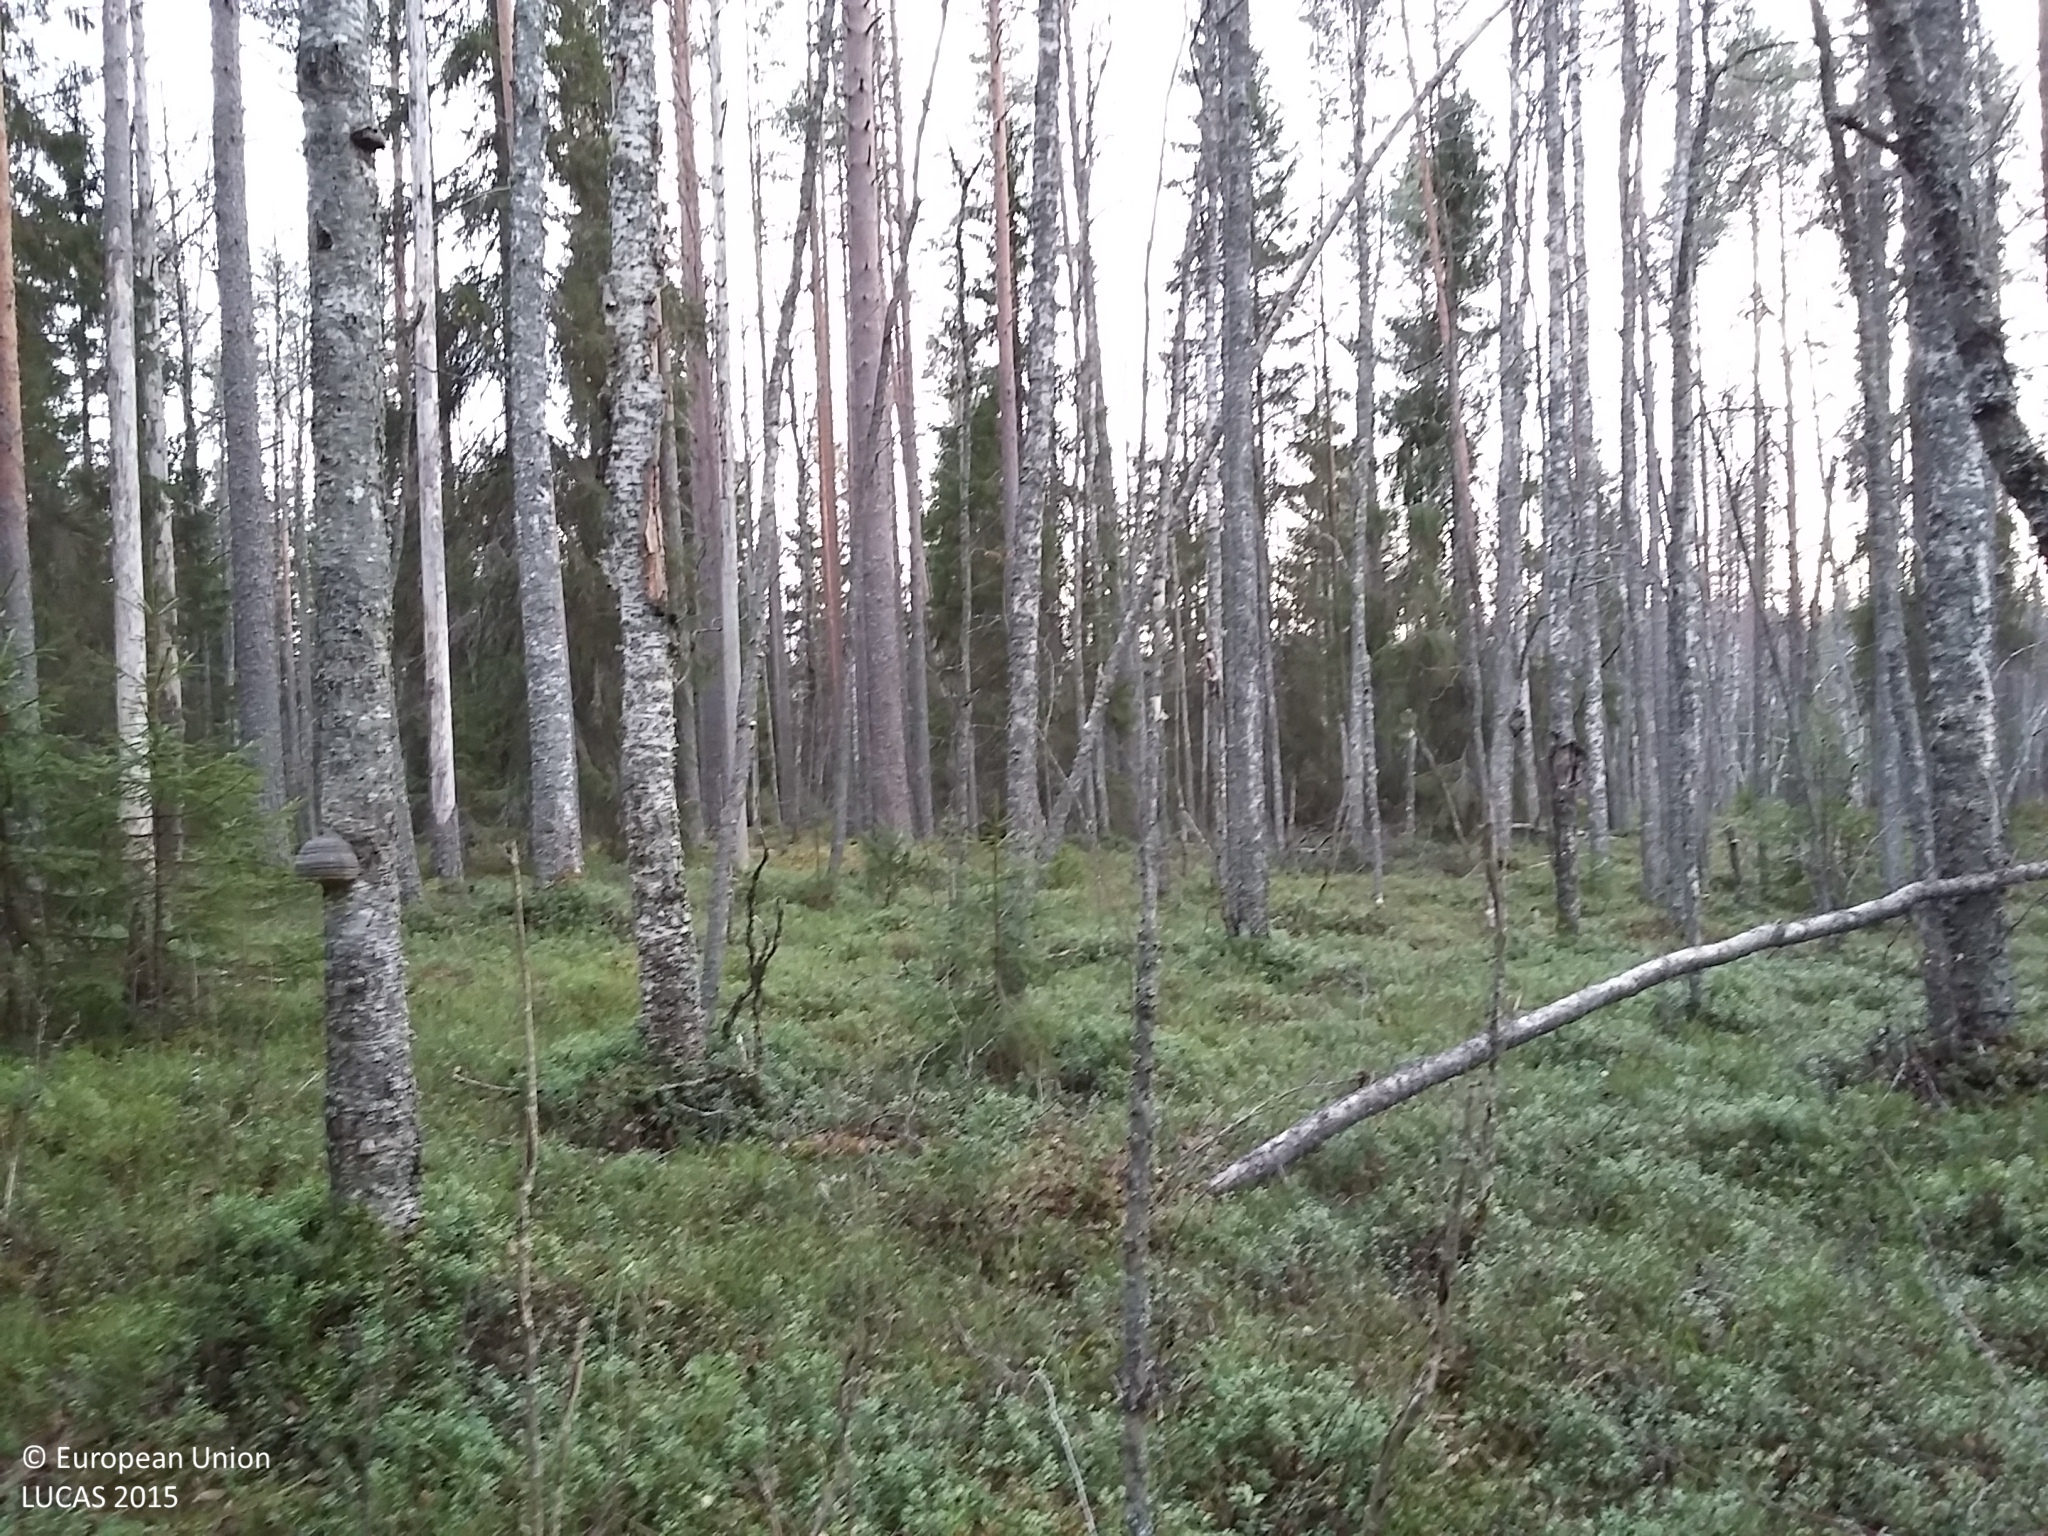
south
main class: Woodland
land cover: Spruce dominated mixed woodland
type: boreal forest
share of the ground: > 75 %
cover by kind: coniferous forest trees 45 %, broadleaved forest trees 35 %, shrubs 10 %, herbaceous plants 5 %, lichens and mosses 5 %
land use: Forestry
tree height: > 5 m
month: October
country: FI
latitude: 64.0510
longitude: 24.9749
